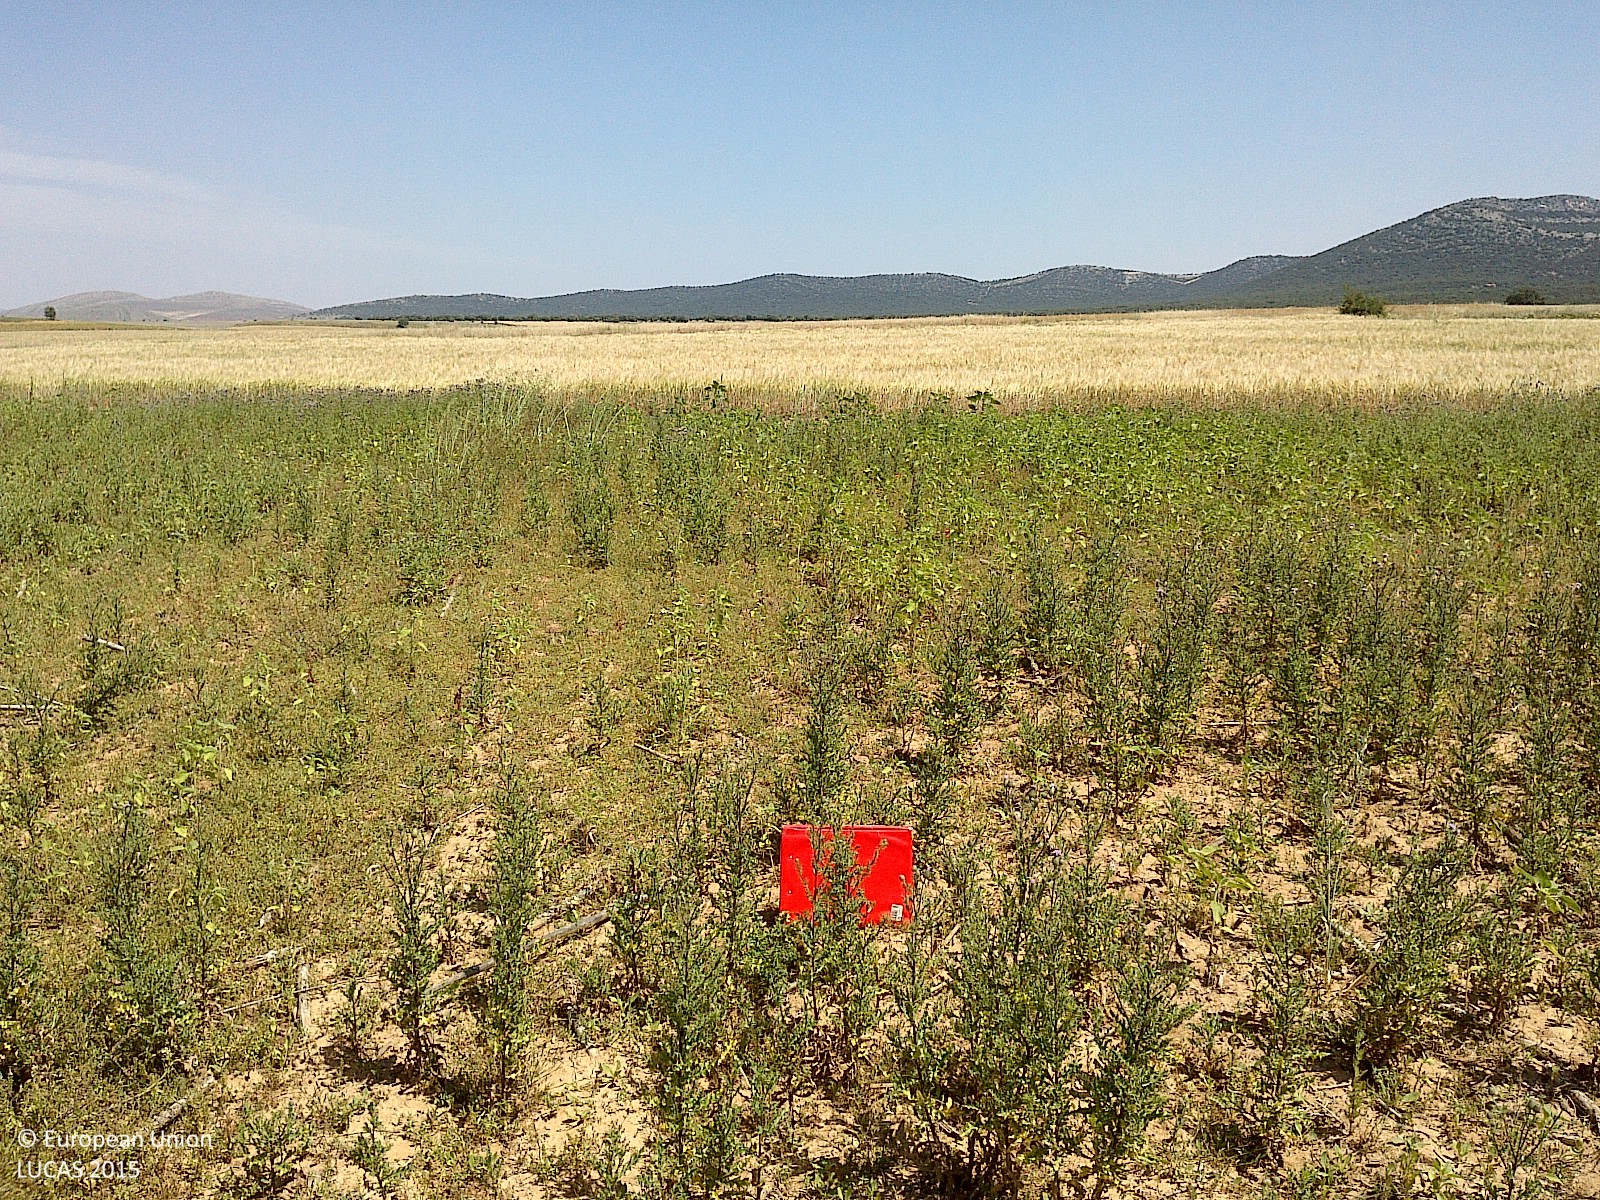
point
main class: Grassland
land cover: Spontaneously vegetated surfaces
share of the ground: > 75 %
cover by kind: herbaceous plants 75 %, unconsolidated bare surface 25 %
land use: Fallow land
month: July
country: ES
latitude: 41.5779
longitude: -2.1099
